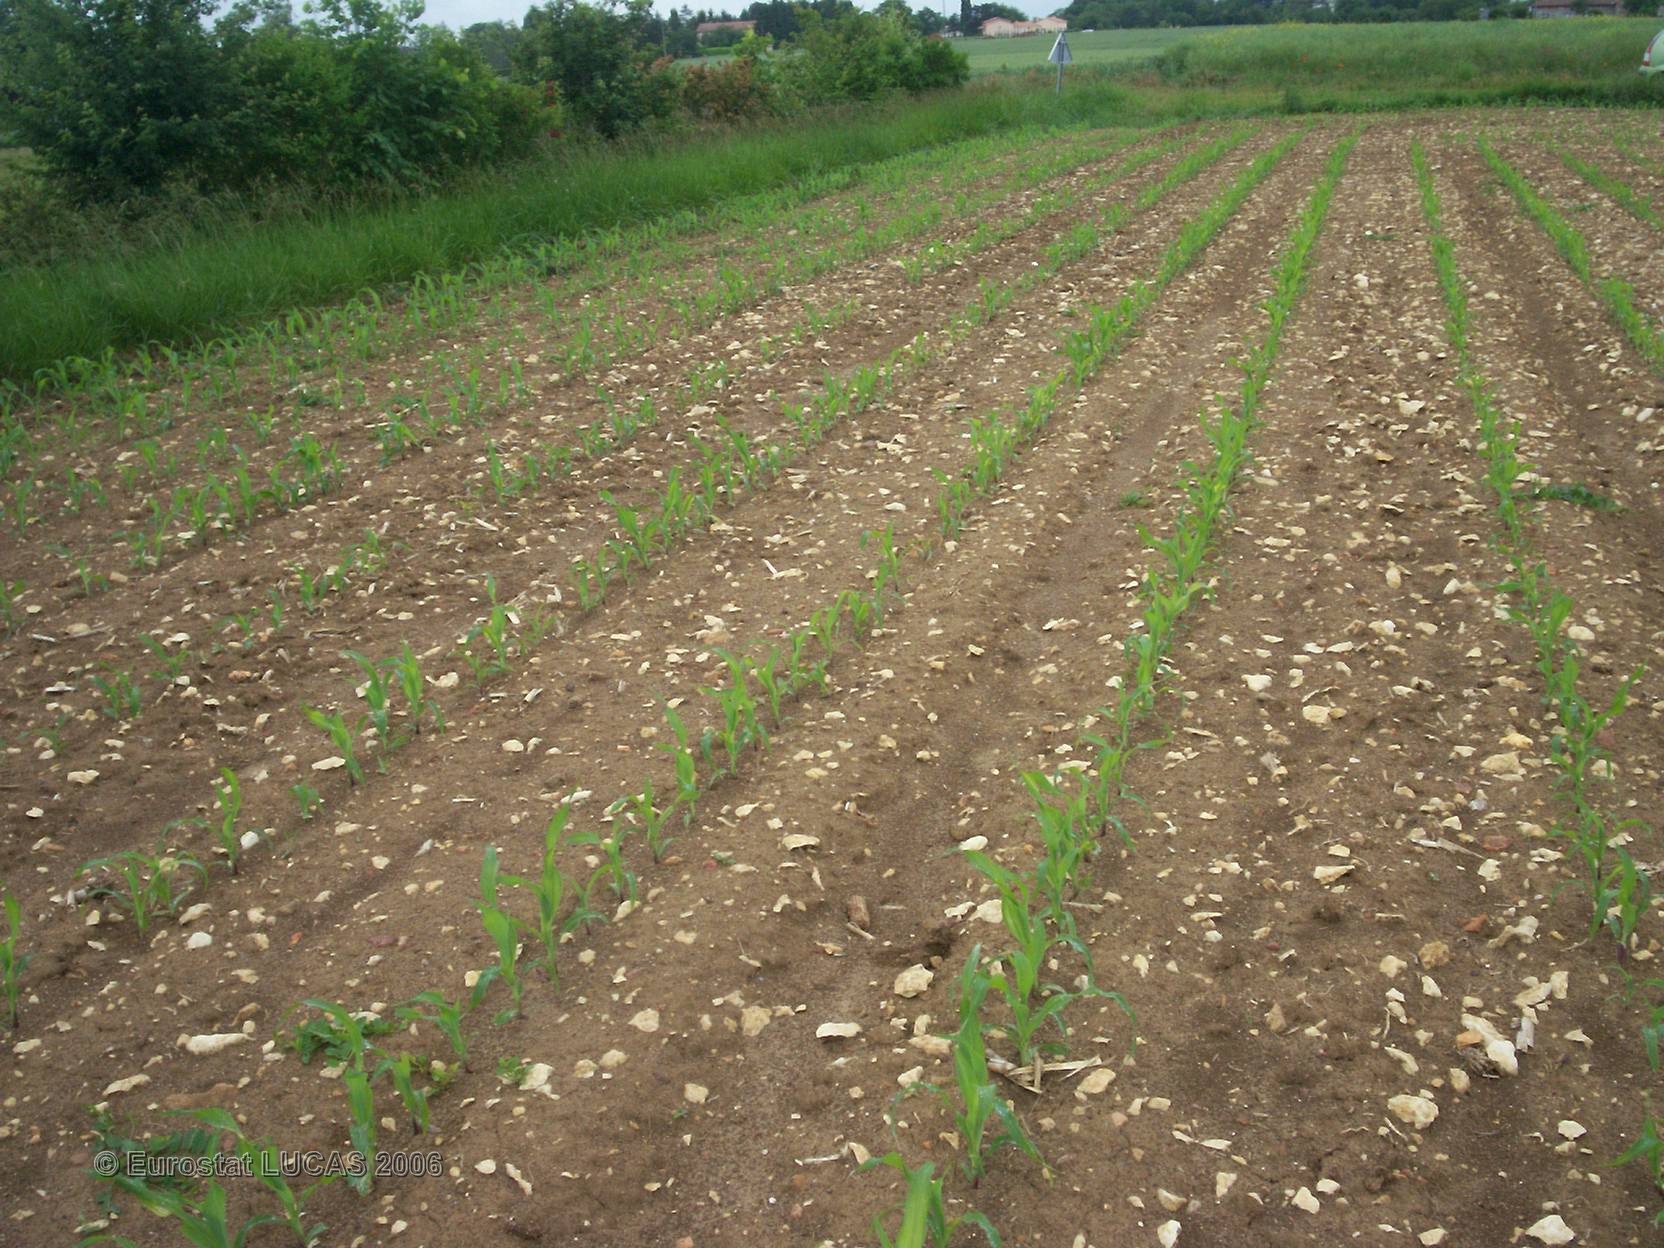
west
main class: Cropland
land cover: Maize
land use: Agriculture (excluding fallow land and kitchen gardens)
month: May
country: FR
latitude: 46.6666
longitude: 0.4533
